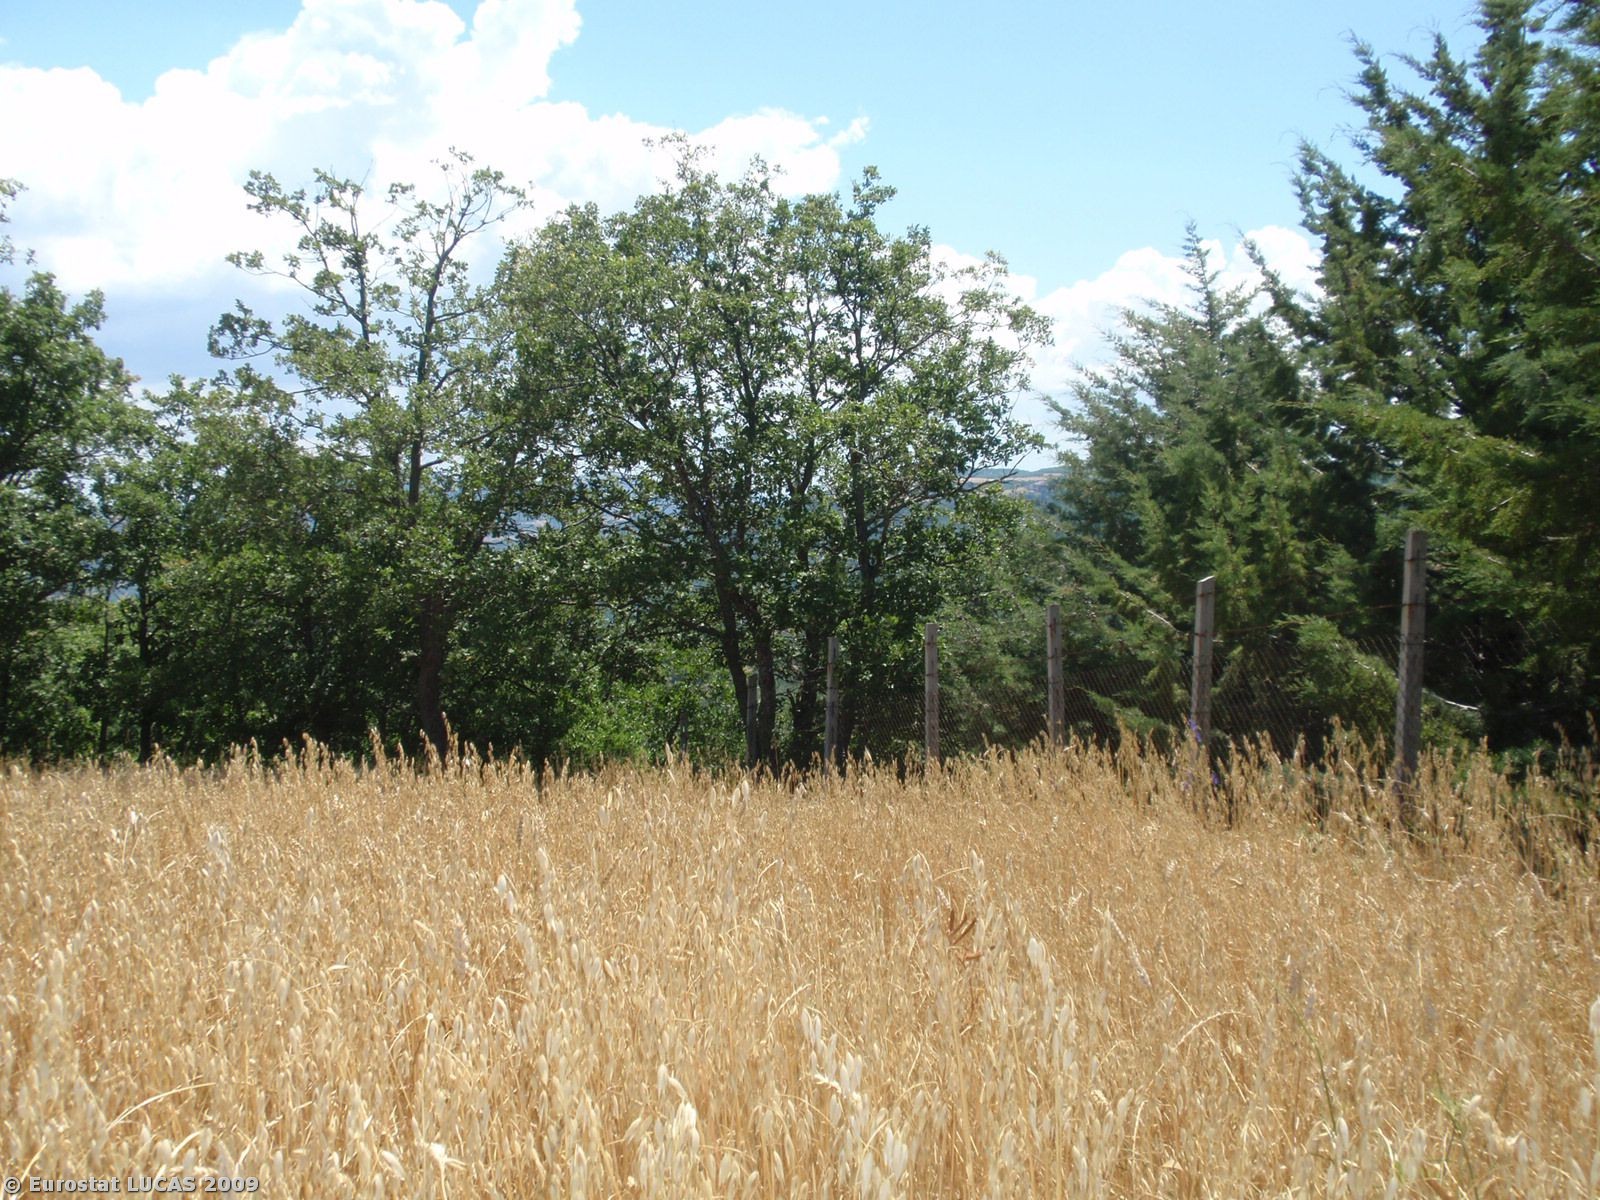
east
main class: Cropland
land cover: Mixed cereals for fodder
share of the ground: > 75 %
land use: Agriculture (excluding fallow land and kitchen gardens)
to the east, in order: Mixed cereals for fodder; Fences; Coniferous woodland; Arable land (only in case pi)
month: June
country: IT
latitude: 40.3144
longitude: 16.0828
